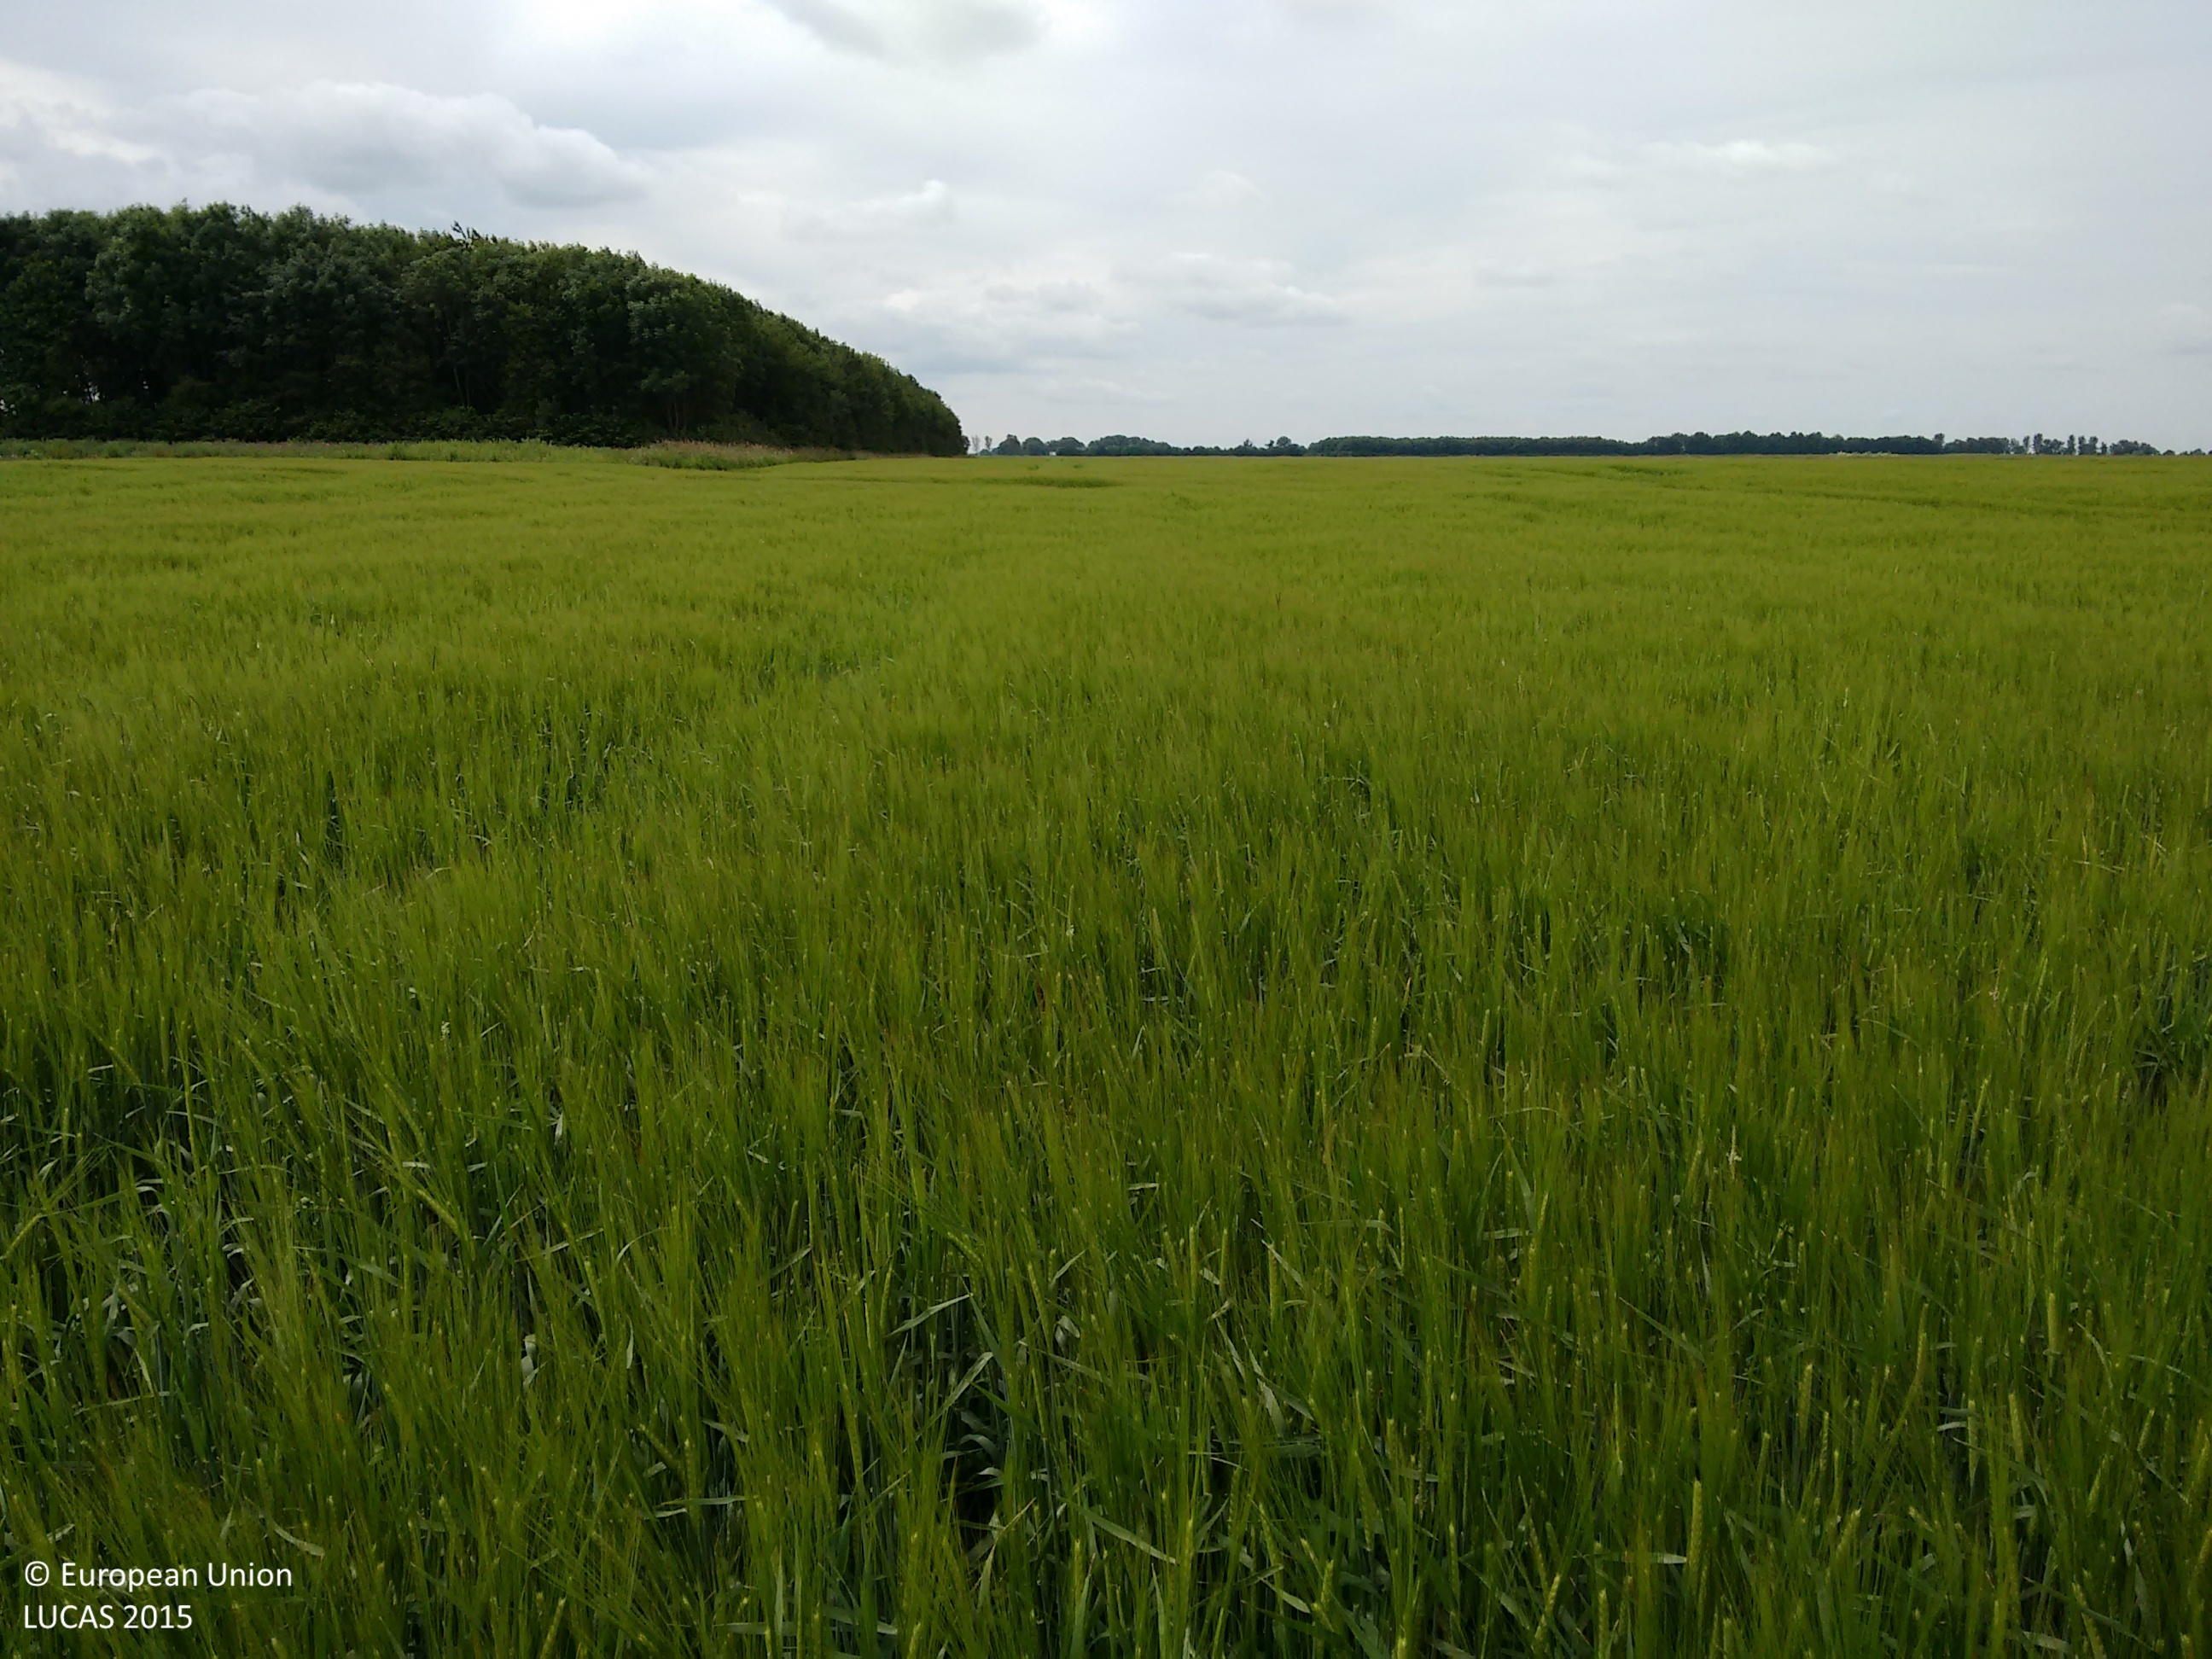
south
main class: Cropland
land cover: Barley
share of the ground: > 75 %
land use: Agriculture (excluding fallow land and kitchen gardens)
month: June
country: GB
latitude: 52.6371
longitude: -0.0666
